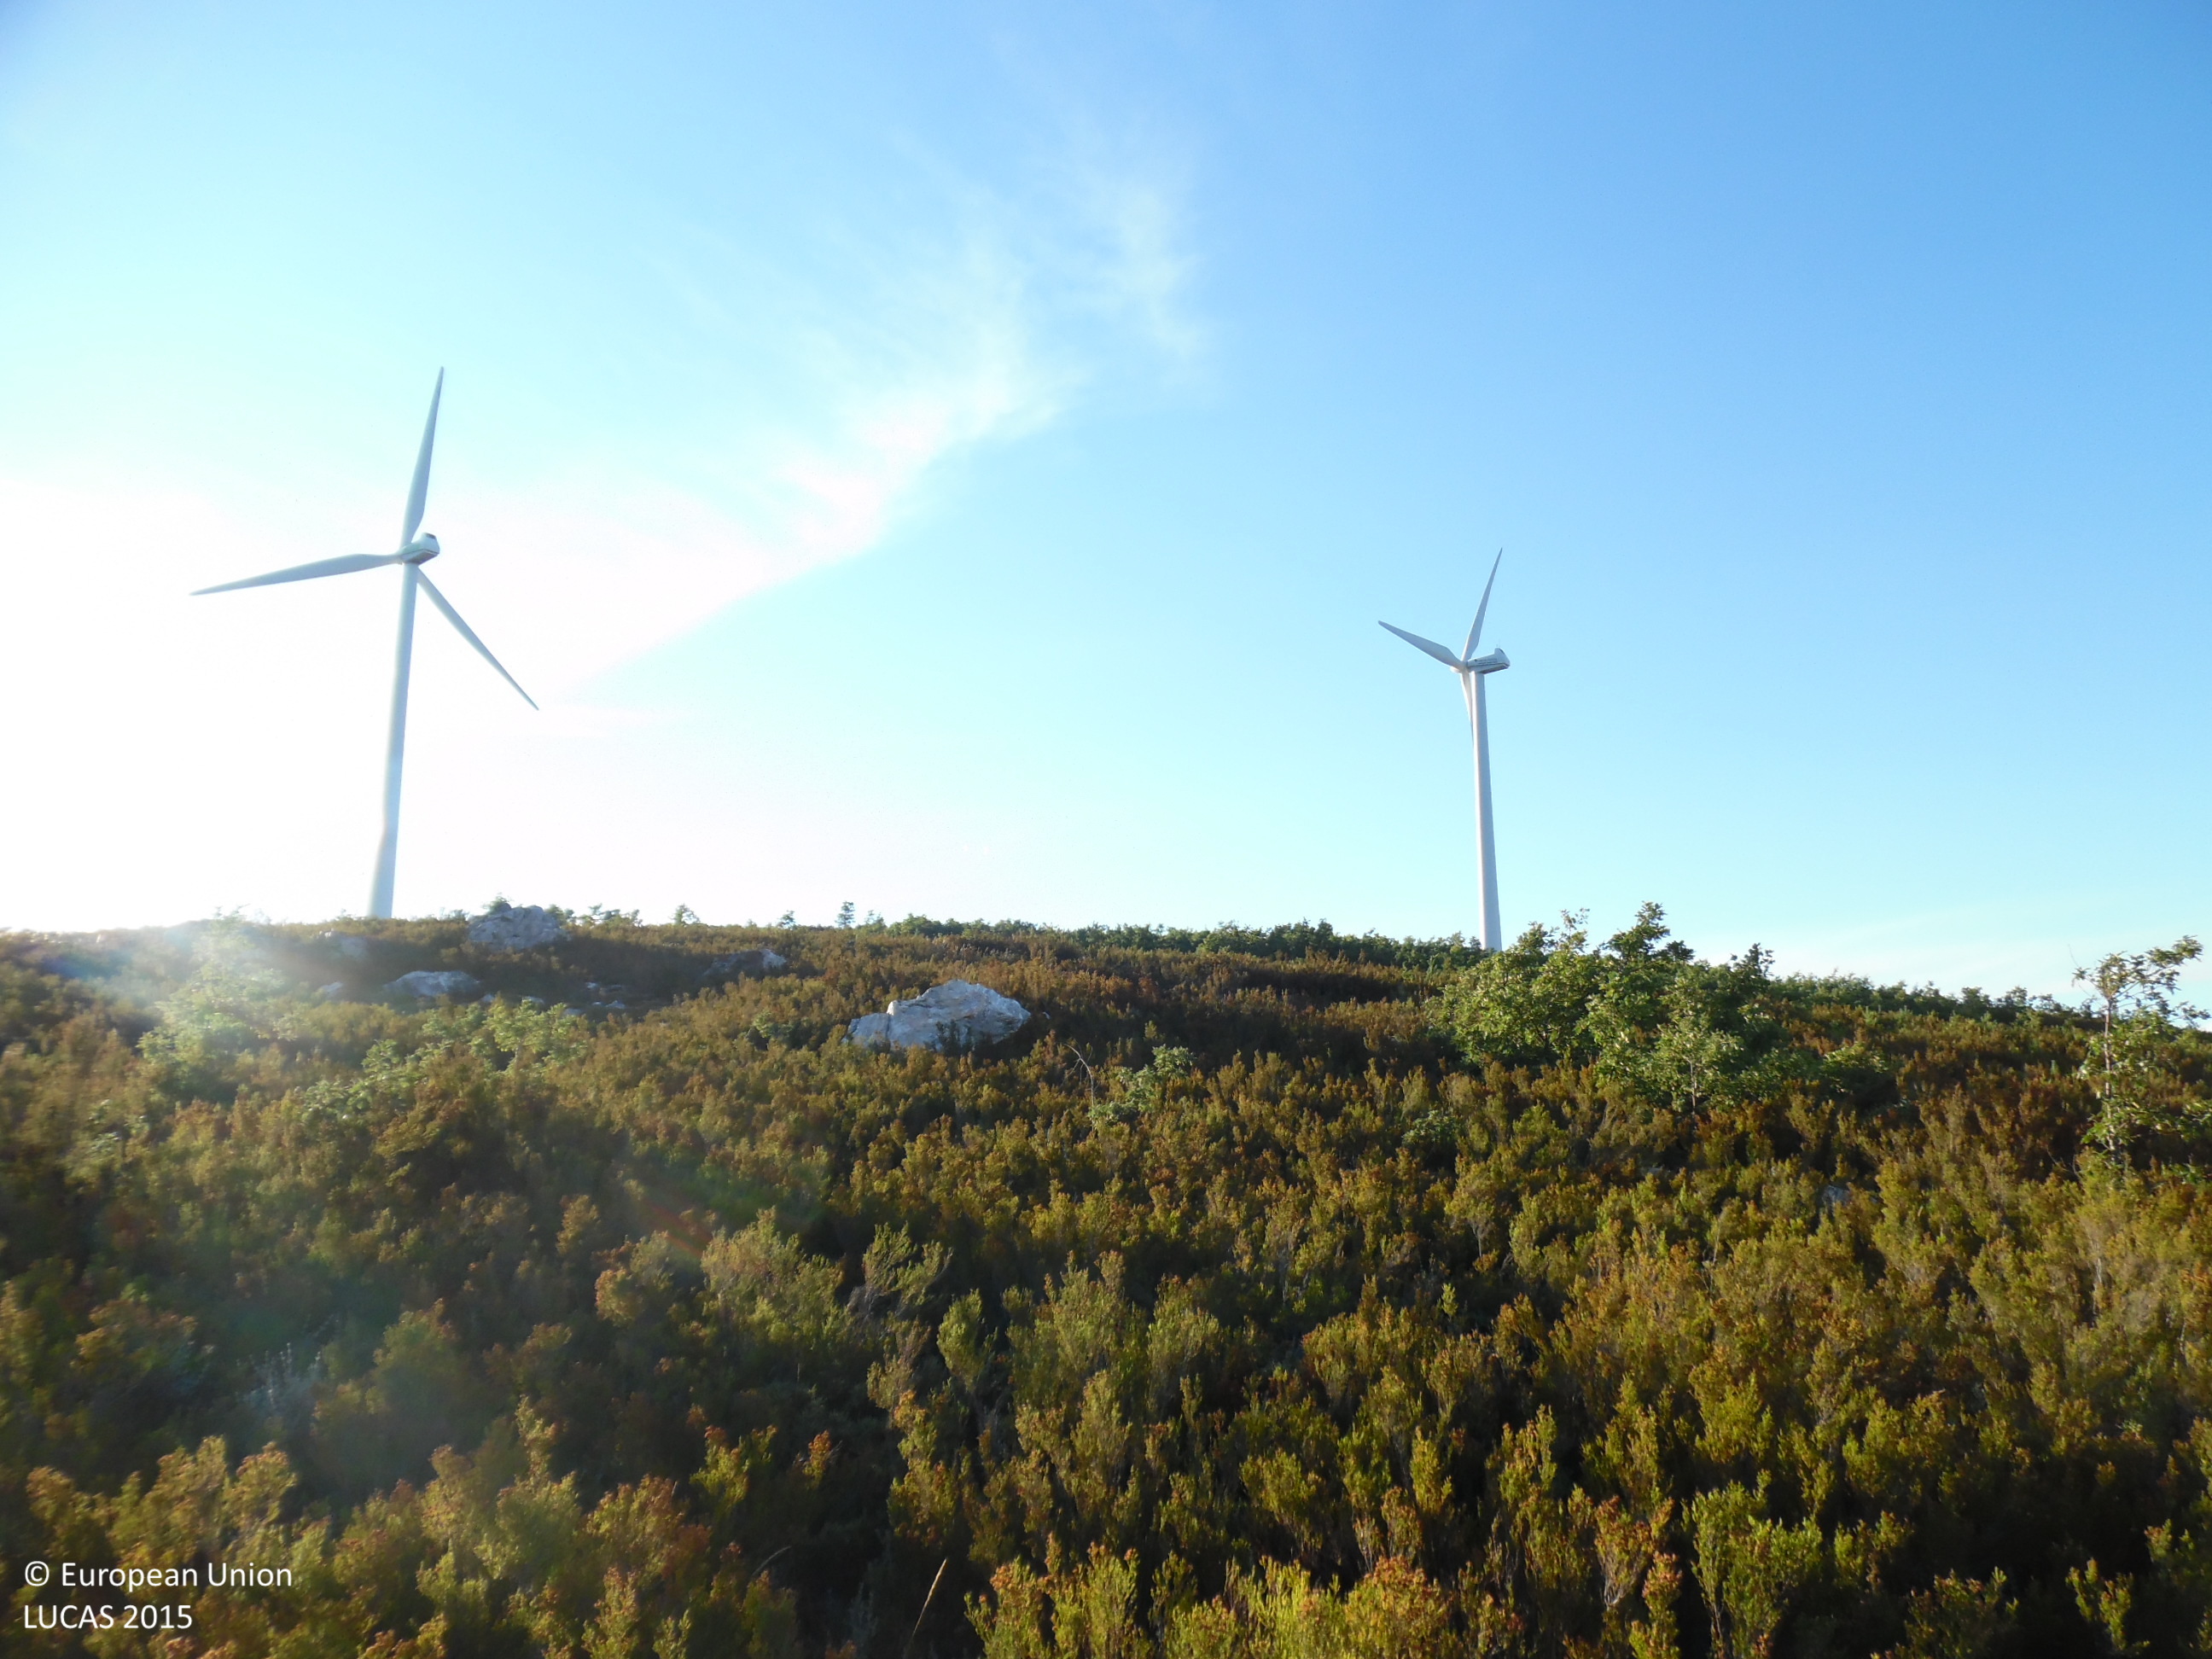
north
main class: Shrubland
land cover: Shrubland without tree cover
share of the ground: > 75 %
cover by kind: shrubs 100 %
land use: Forestry
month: July
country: ES
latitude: 42.5572
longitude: -6.3992
